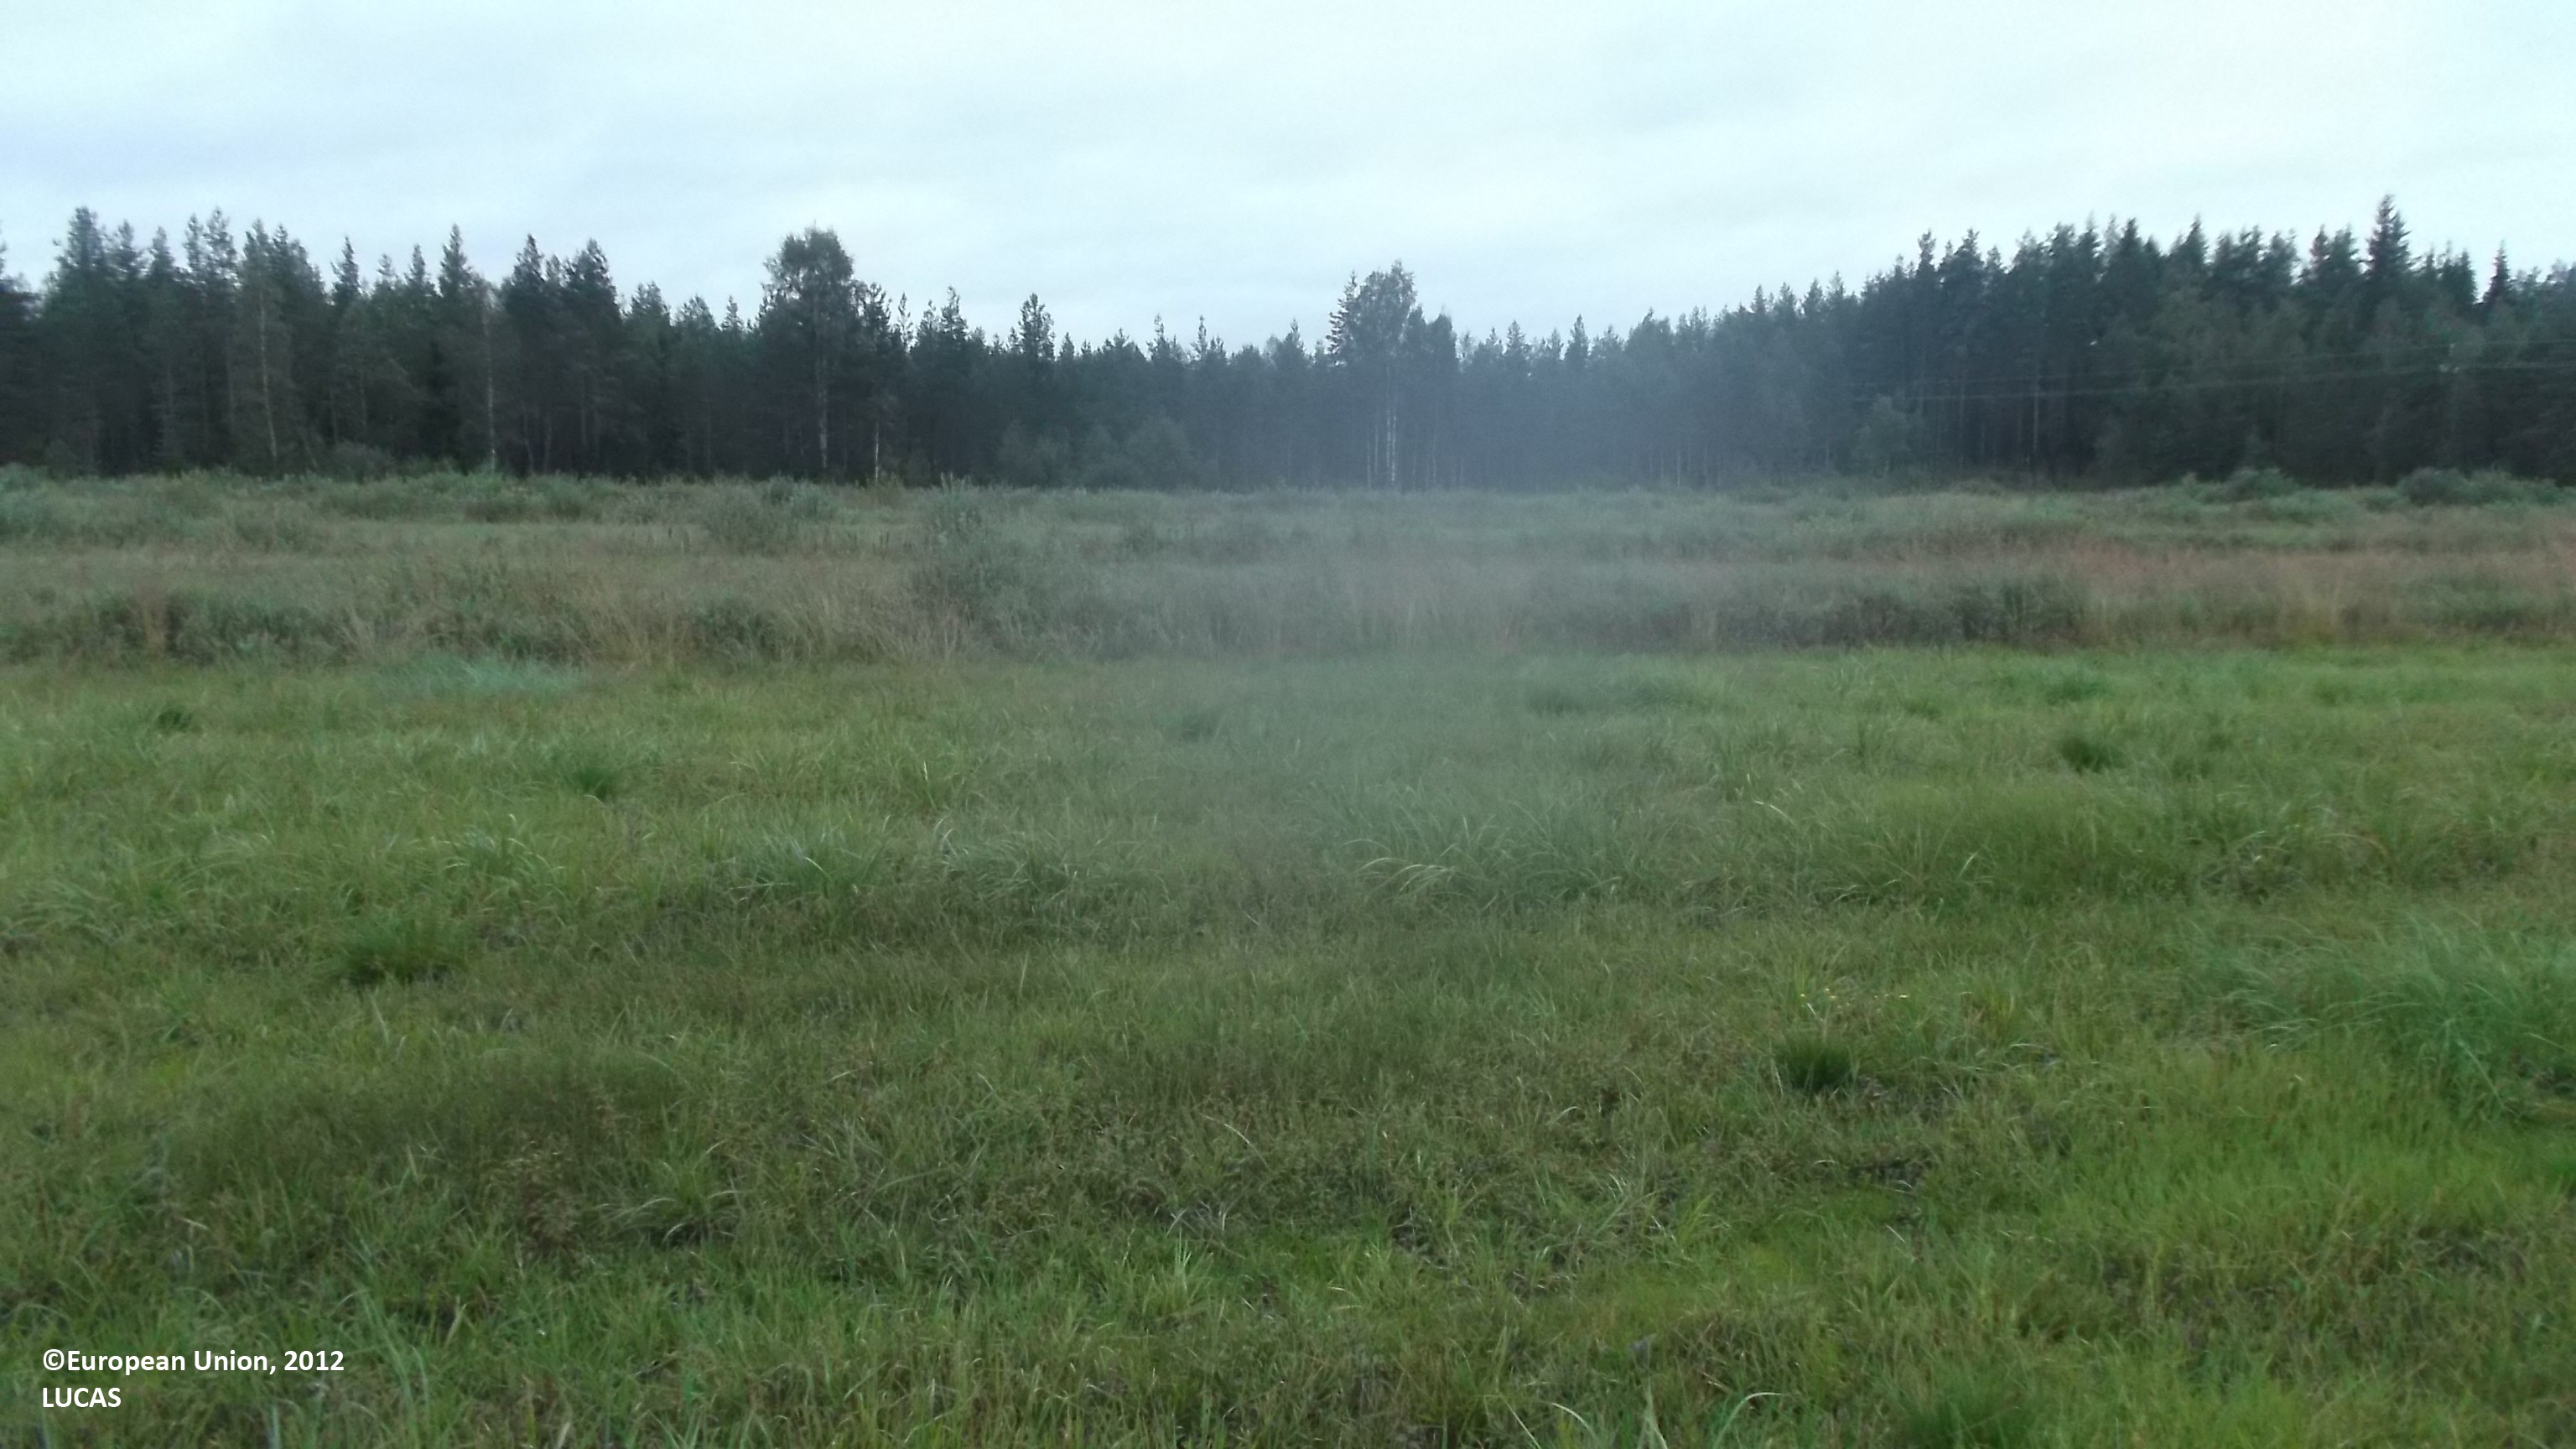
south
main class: Cropland
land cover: Temporary grasslands
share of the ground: > 75 %
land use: Agriculture (excluding fallow land and kitchen gardens)
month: August
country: FI
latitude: 63.2328
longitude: 24.4714
